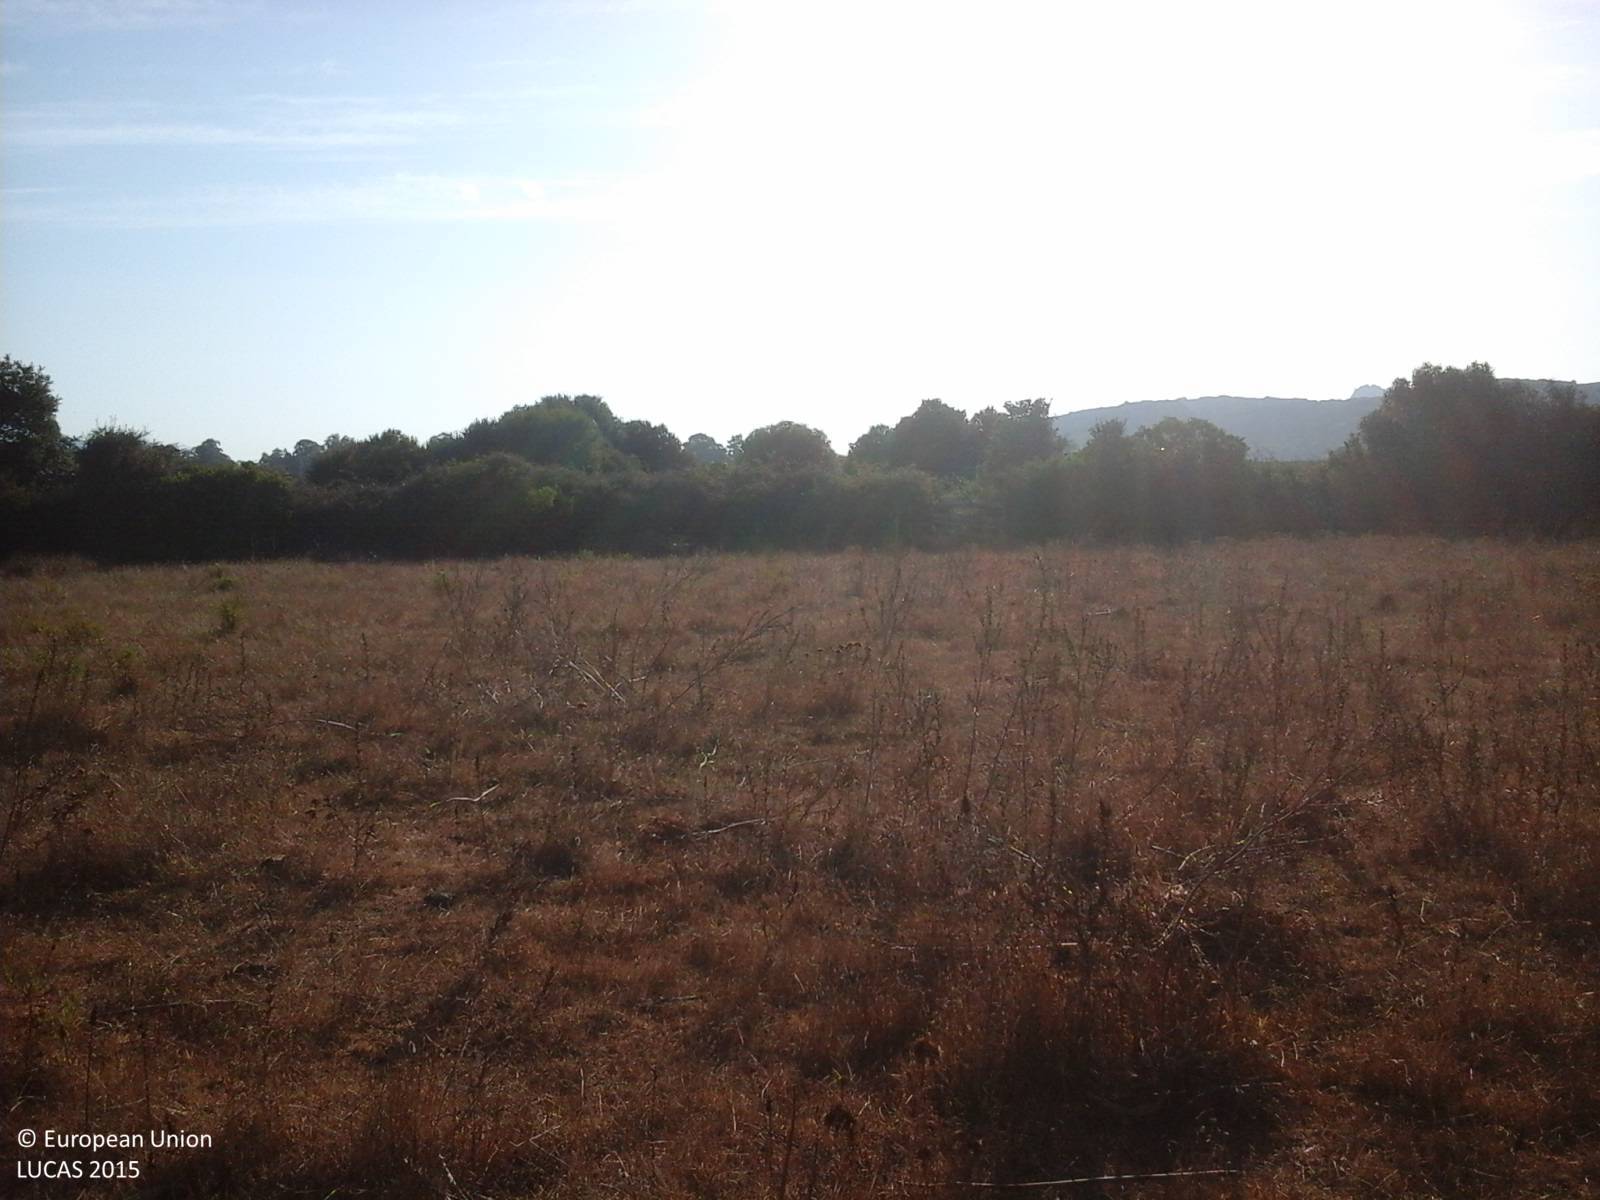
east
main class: Grassland
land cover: Grassland without tree/shrub cover
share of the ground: > 75 %
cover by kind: herbaceous plants 95 %, shrubs 5 %
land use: Agriculture (excluding fallow land and kitchen gardens)
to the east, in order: Grassland without tree/shrub cover; Abandoned hedges; Dry stone walls; Shrubland with sparse tree cover; Single bushes/trees; Ditches and canals; Grass margins; Grassland without tree/shrub cover; Abandoned hedges; Grassland without tree/shrub cover
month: September
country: IT
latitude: 41.0618
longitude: 9.4196
